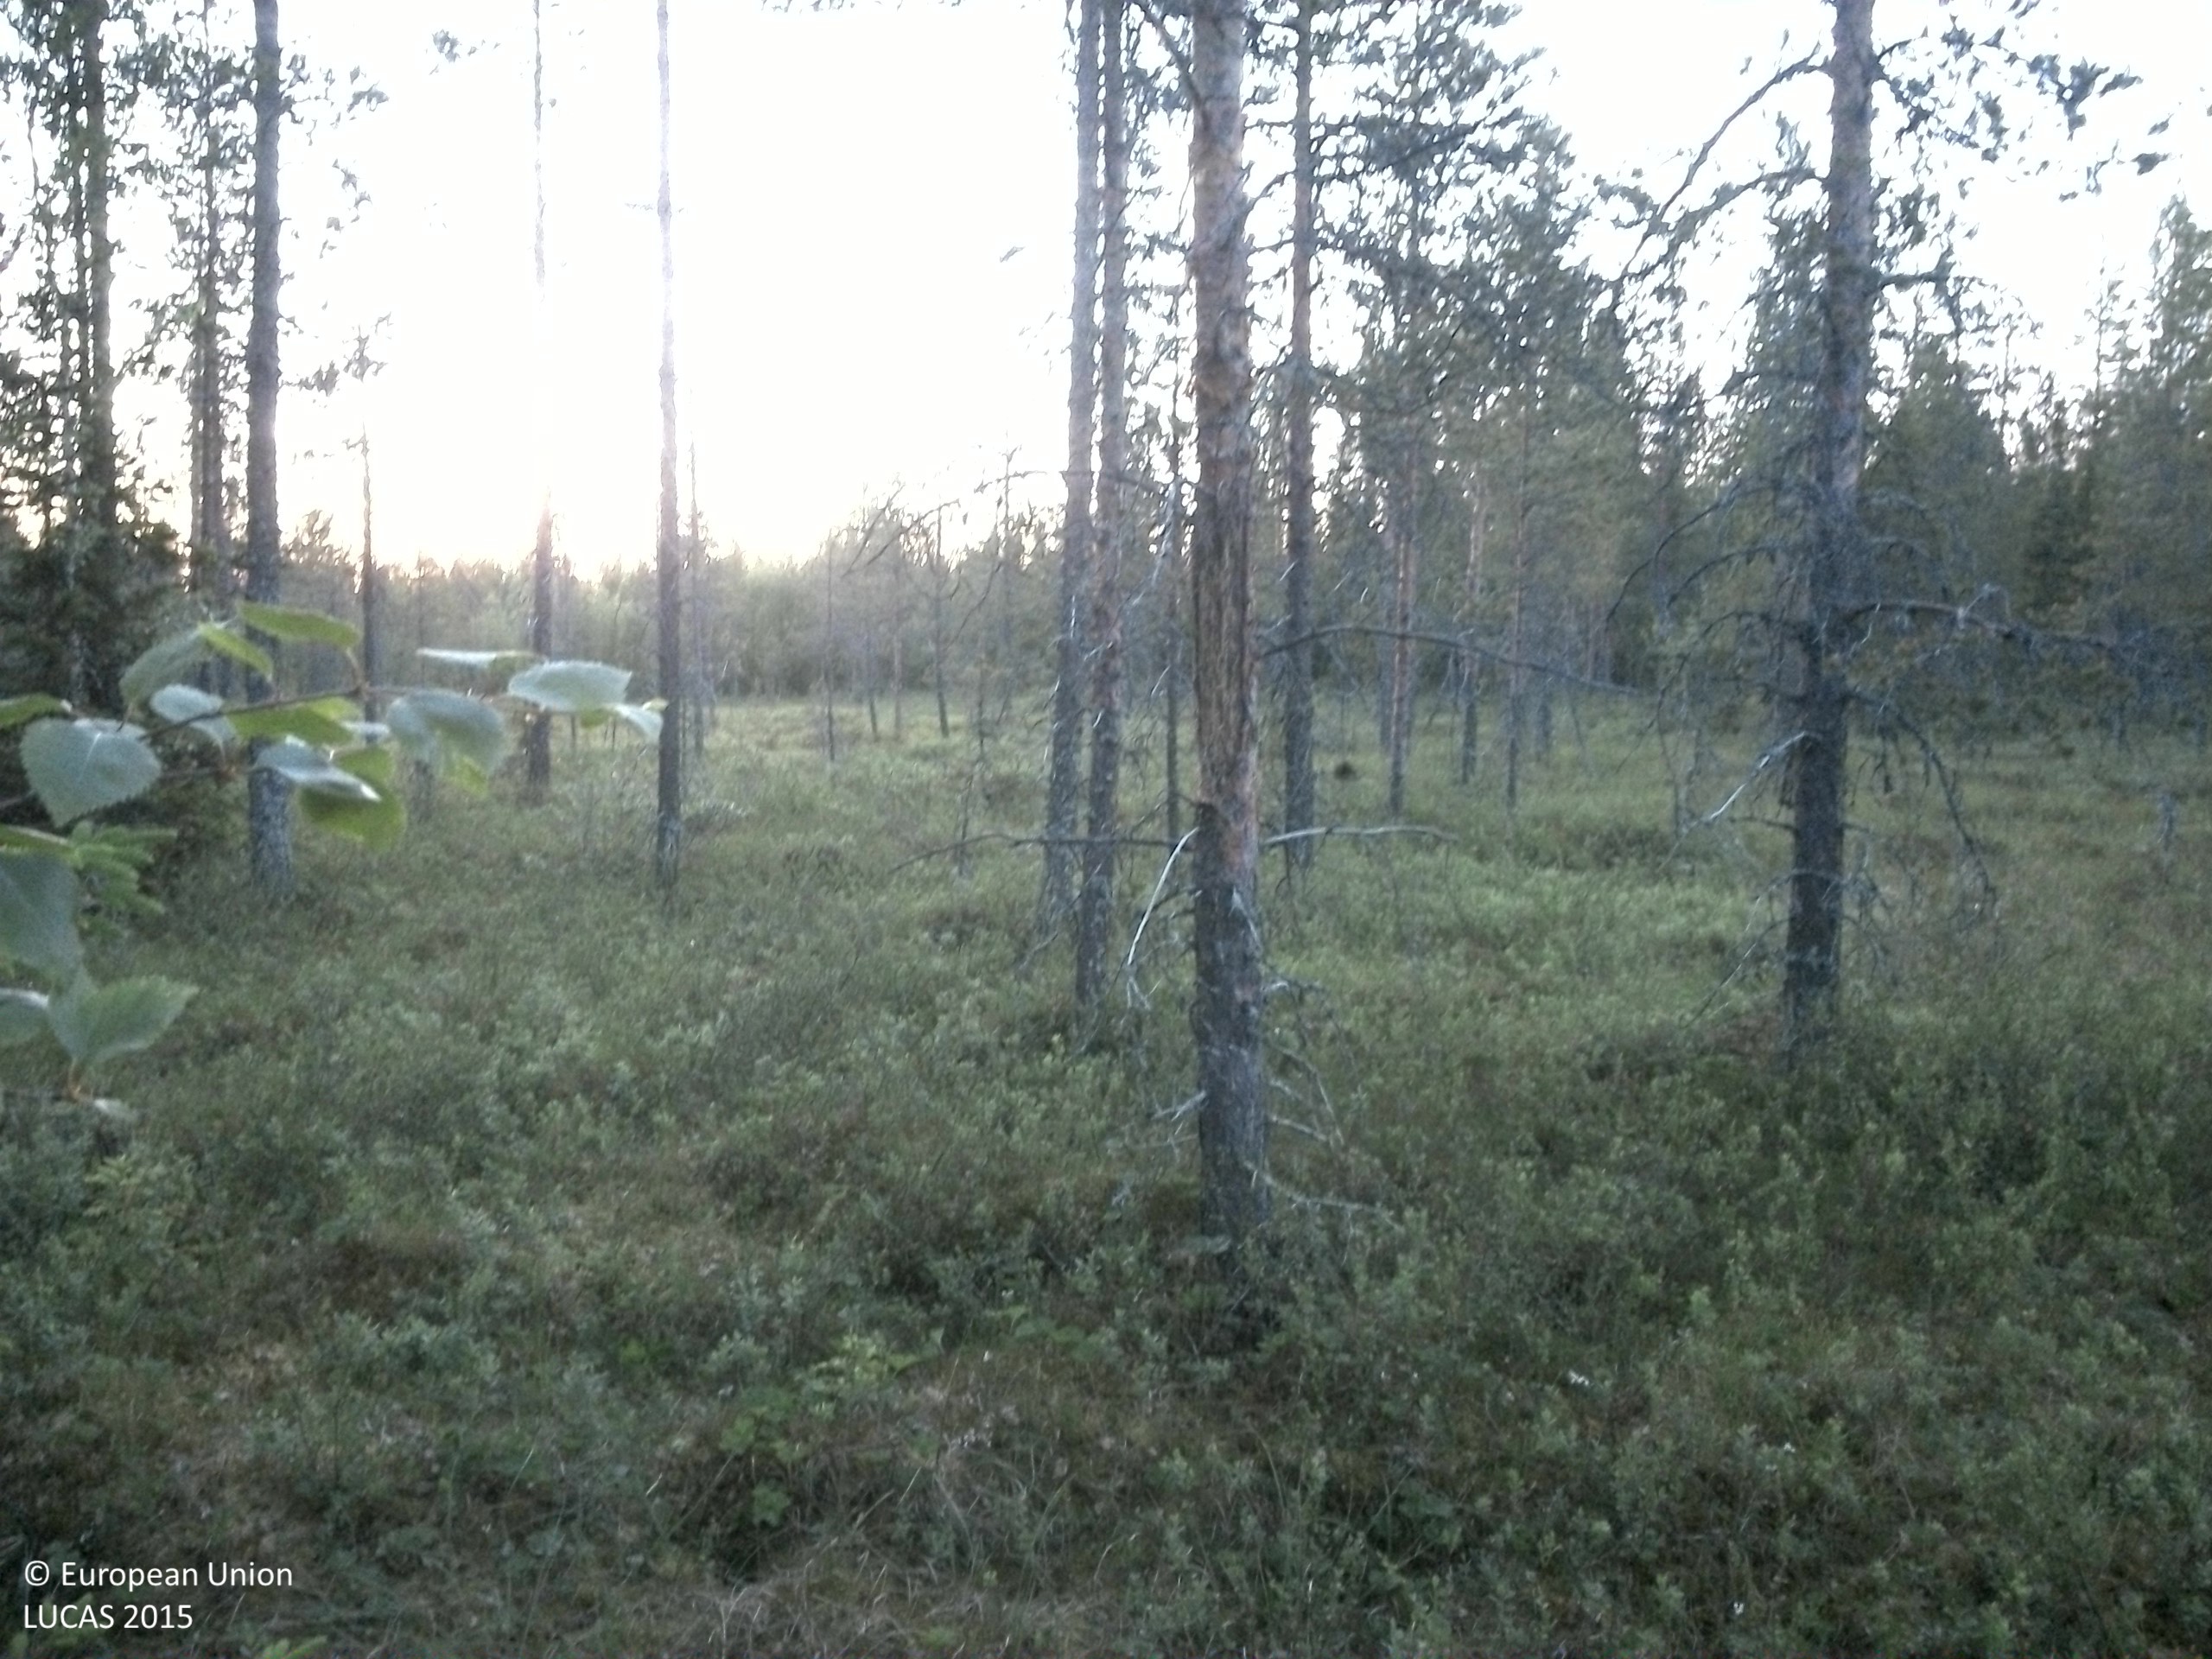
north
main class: Woodland
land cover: Pine dominated coniferous woodland
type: boreal forest
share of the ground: 25 - 50 %
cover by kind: shrubs 55 %, coniferous forest trees 20 %, lichens and mosses 15 %, broadleaved forest trees 5 %, herbaceous plants 5 %
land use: Forestry
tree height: > 5 m
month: July
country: SE
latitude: 64.3028
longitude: 16.8930
